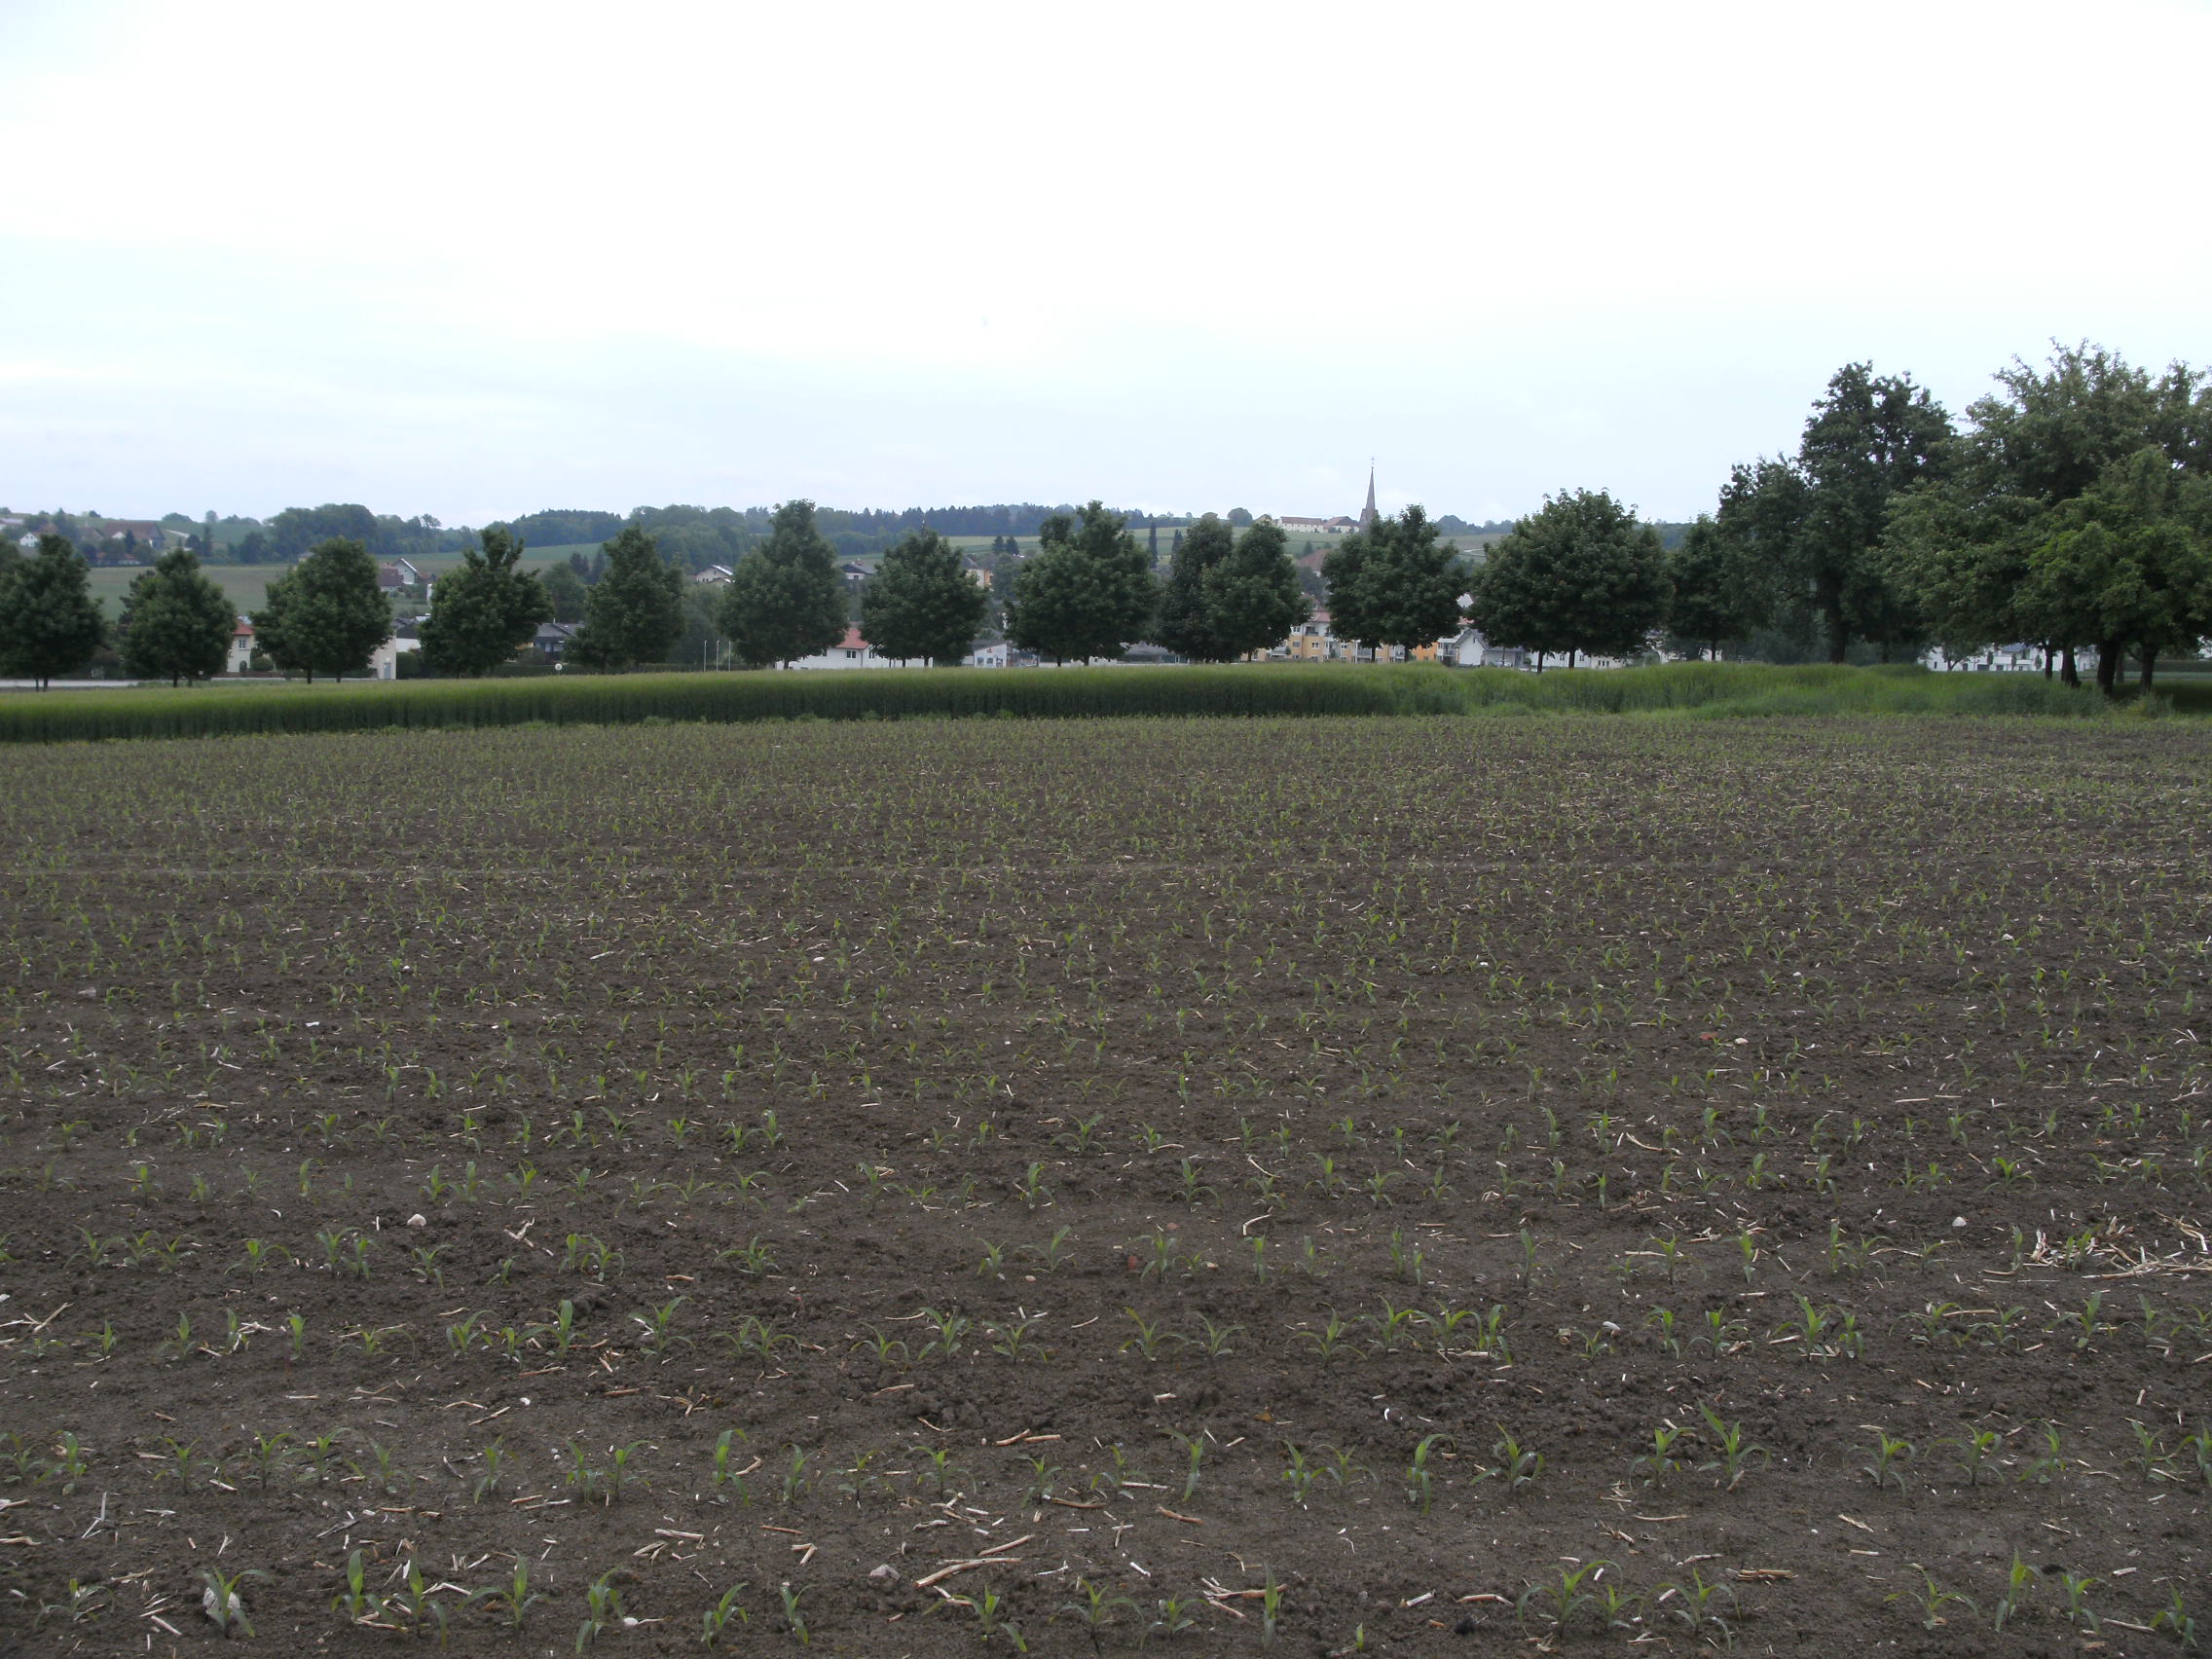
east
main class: Cropland
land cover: Maize
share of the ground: < 10 %
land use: Agriculture (excluding fallow land and kitchen gardens)
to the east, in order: Maize; Barley; Lines of trees; Tracks; Lines of trees; Other bare soil
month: May
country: AT
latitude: 48.3492
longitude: 13.4673
